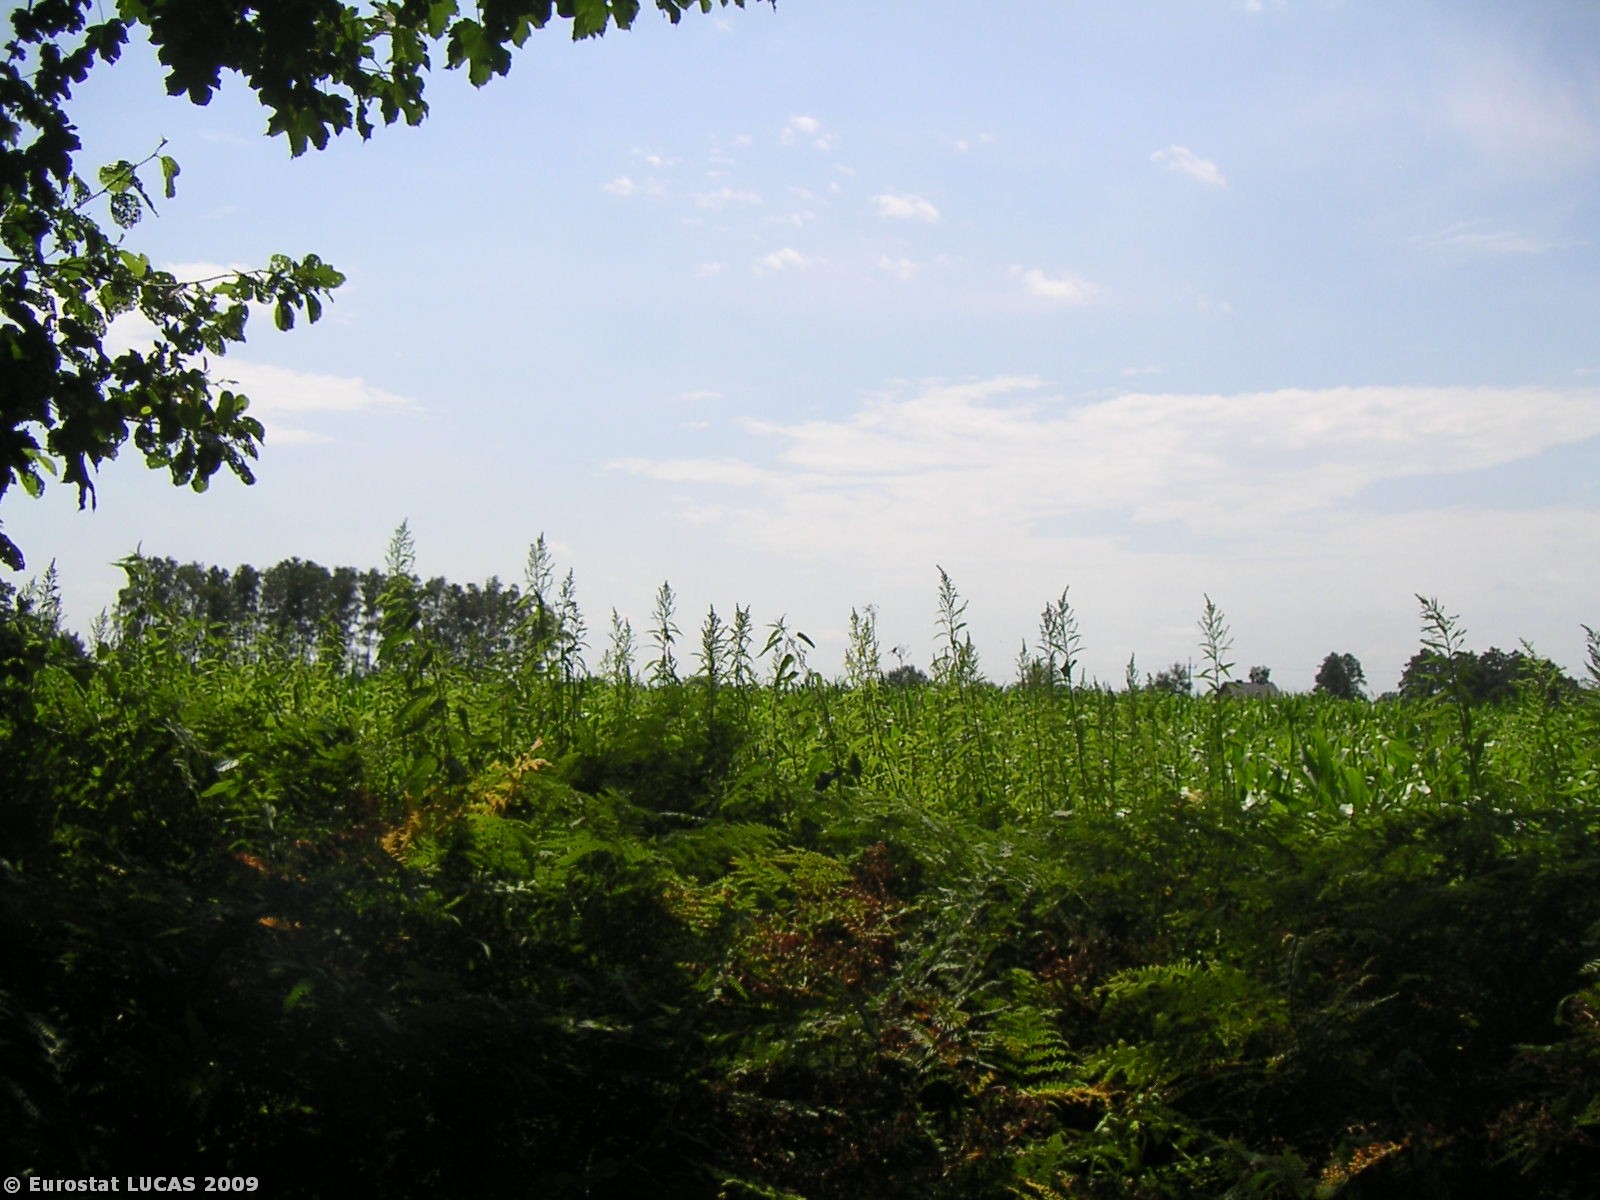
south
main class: Woodland
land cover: Mixed woodland
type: hemiboreal forest and nemoral coniferous forest and mixed broadleaved-coniferous forest
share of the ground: > 75 %
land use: Forestry
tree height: > 5 m
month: July
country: PL
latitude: 50.0108
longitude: 18.7421
